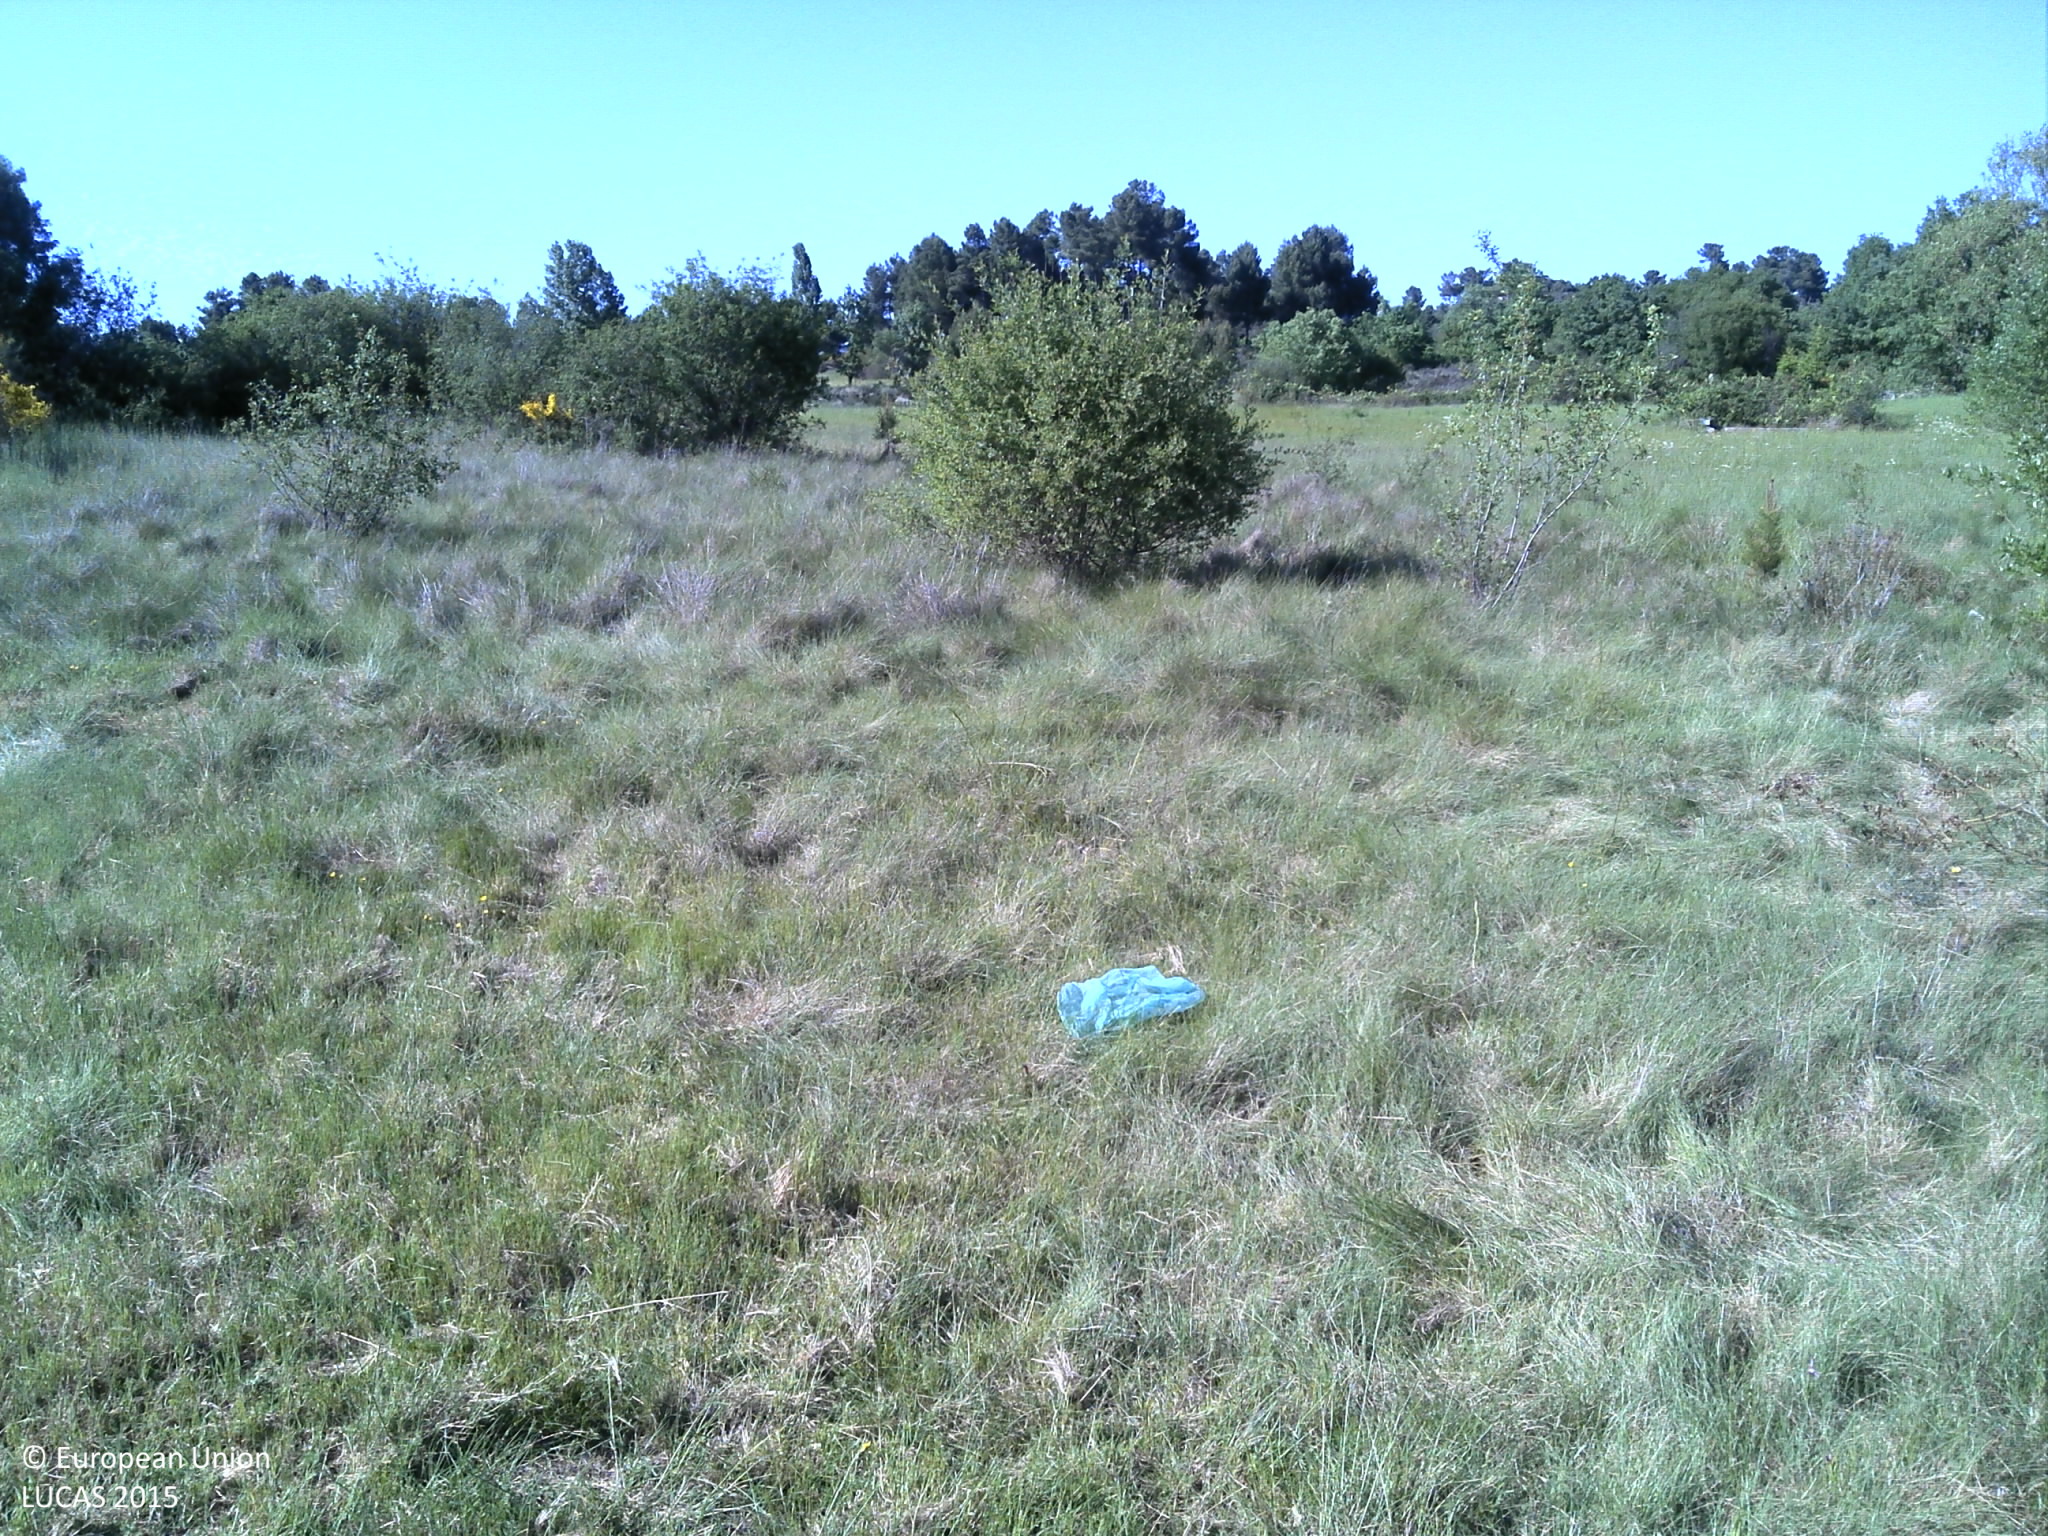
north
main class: Grassland
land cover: Grassland without tree/shrub cover
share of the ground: > 75 %
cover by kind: herbaceous plants 80 %, unconsolidated bare surface 15 %, shrubs 5 %
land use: Agriculture (excluding fallow land and kitchen gardens)
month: May
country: PT
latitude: 41.5636
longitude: -7.5775
